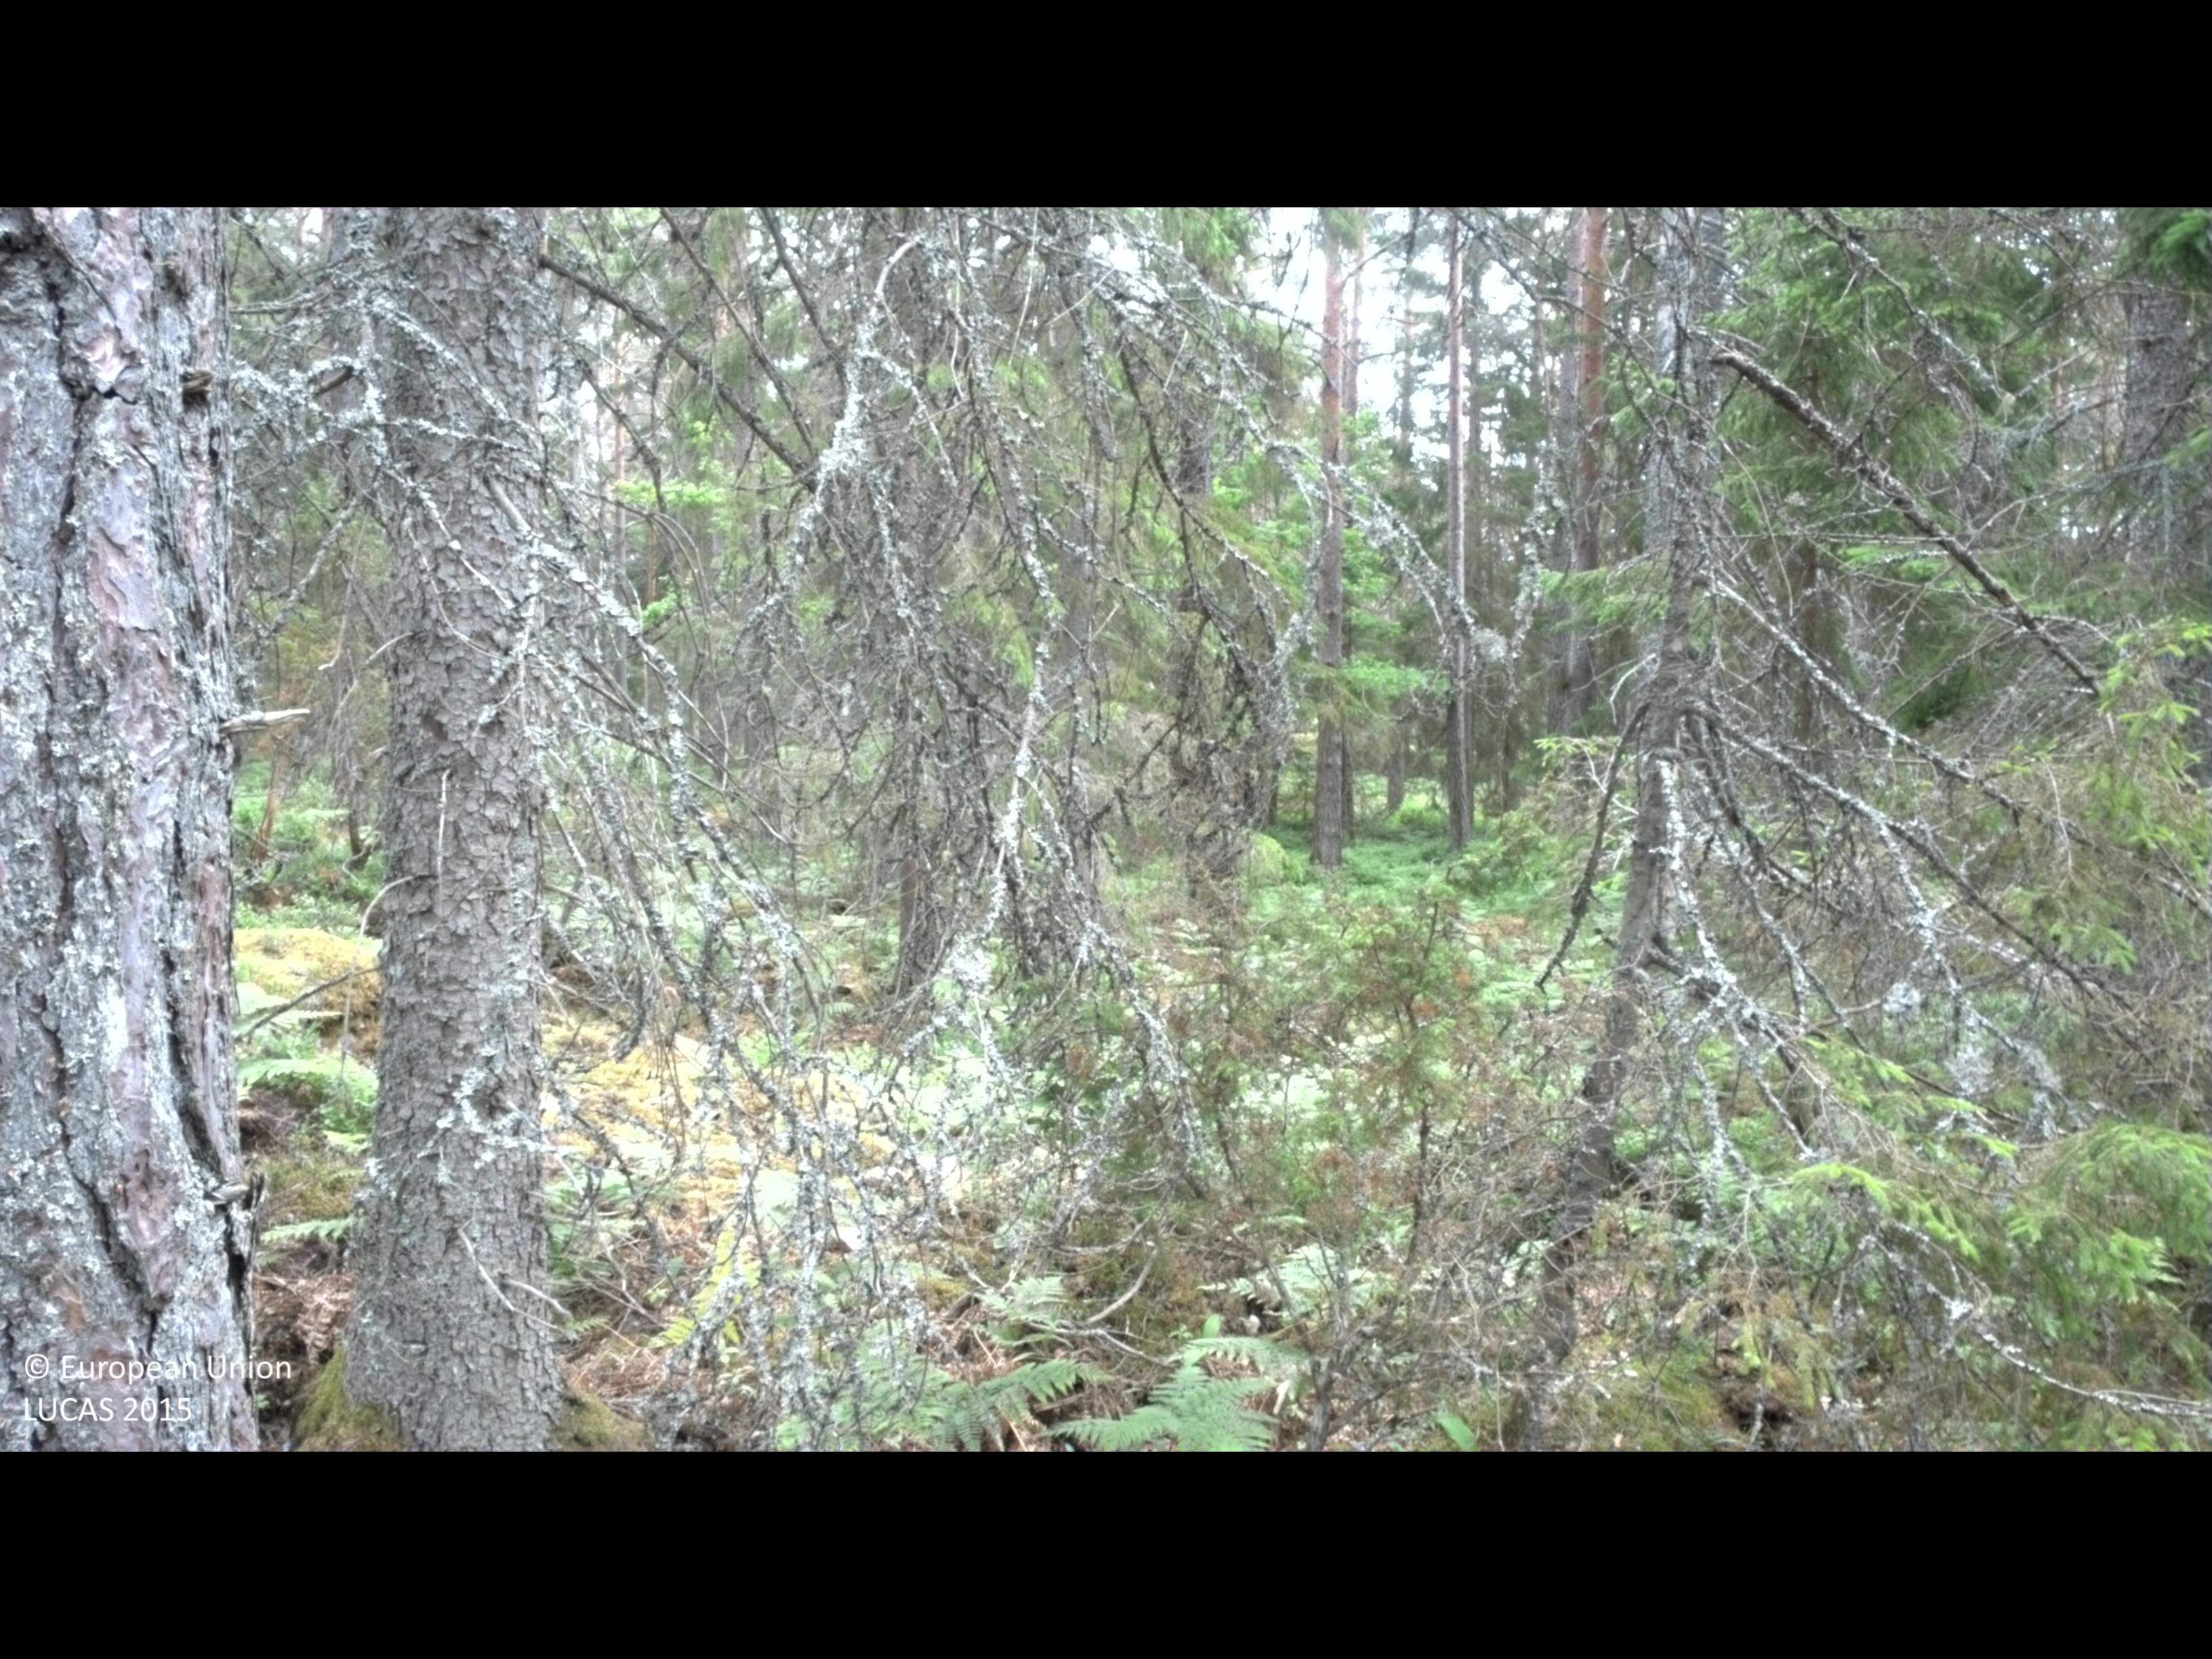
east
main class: Woodland
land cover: Spruce dominated coniferous woodland
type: boreal forest
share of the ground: > 75 %
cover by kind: coniferous forest trees 75 %, shrubs 15 %, herbaceous plants 5 %, lichens and mosses 5 %
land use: Forestry
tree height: > 5 m
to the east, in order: Spruce dominated coniferous woodland; Pine dominated coniferous woodland; Spruce dominated coniferous woodland; Pine dominated mixed woodland; Paved roads, cycling and walking lanes; Pine dominated coniferous woodland
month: June
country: SE
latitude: 57.9326
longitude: 16.5674
